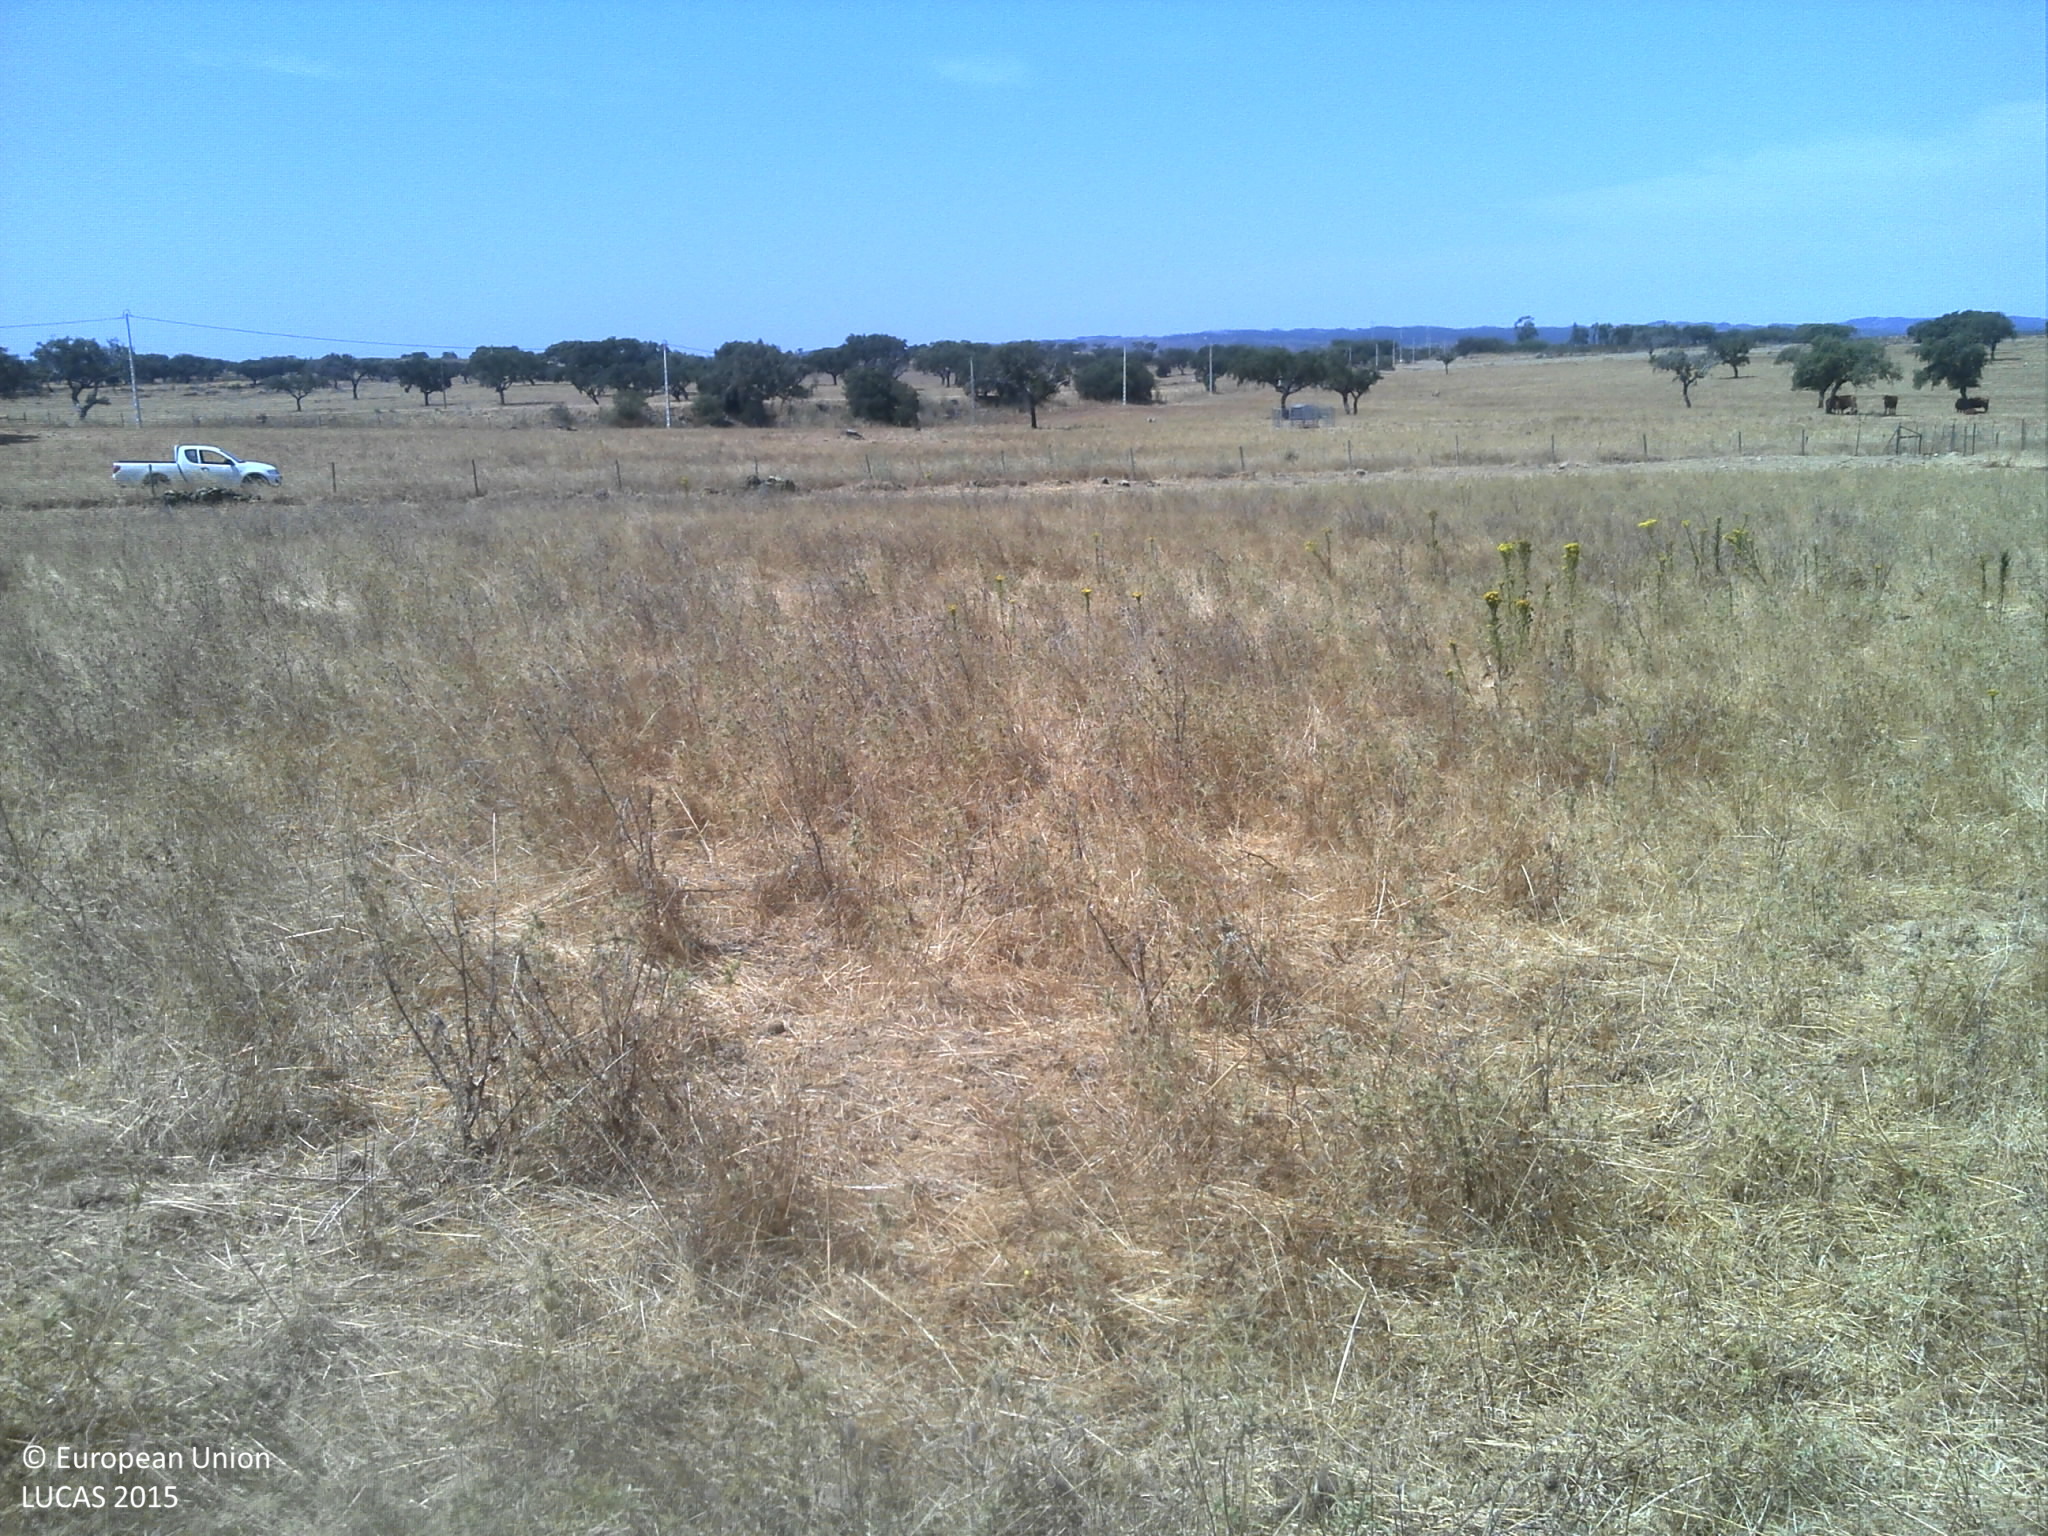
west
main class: Grassland
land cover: Grassland without tree/shrub cover
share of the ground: 25 - 50 %
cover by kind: herbaceous plants 60 %, consolidated bare surface 40 %
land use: Agriculture (excluding fallow land and kitchen gardens)
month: July
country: PT
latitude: 37.6829
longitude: -8.2756
